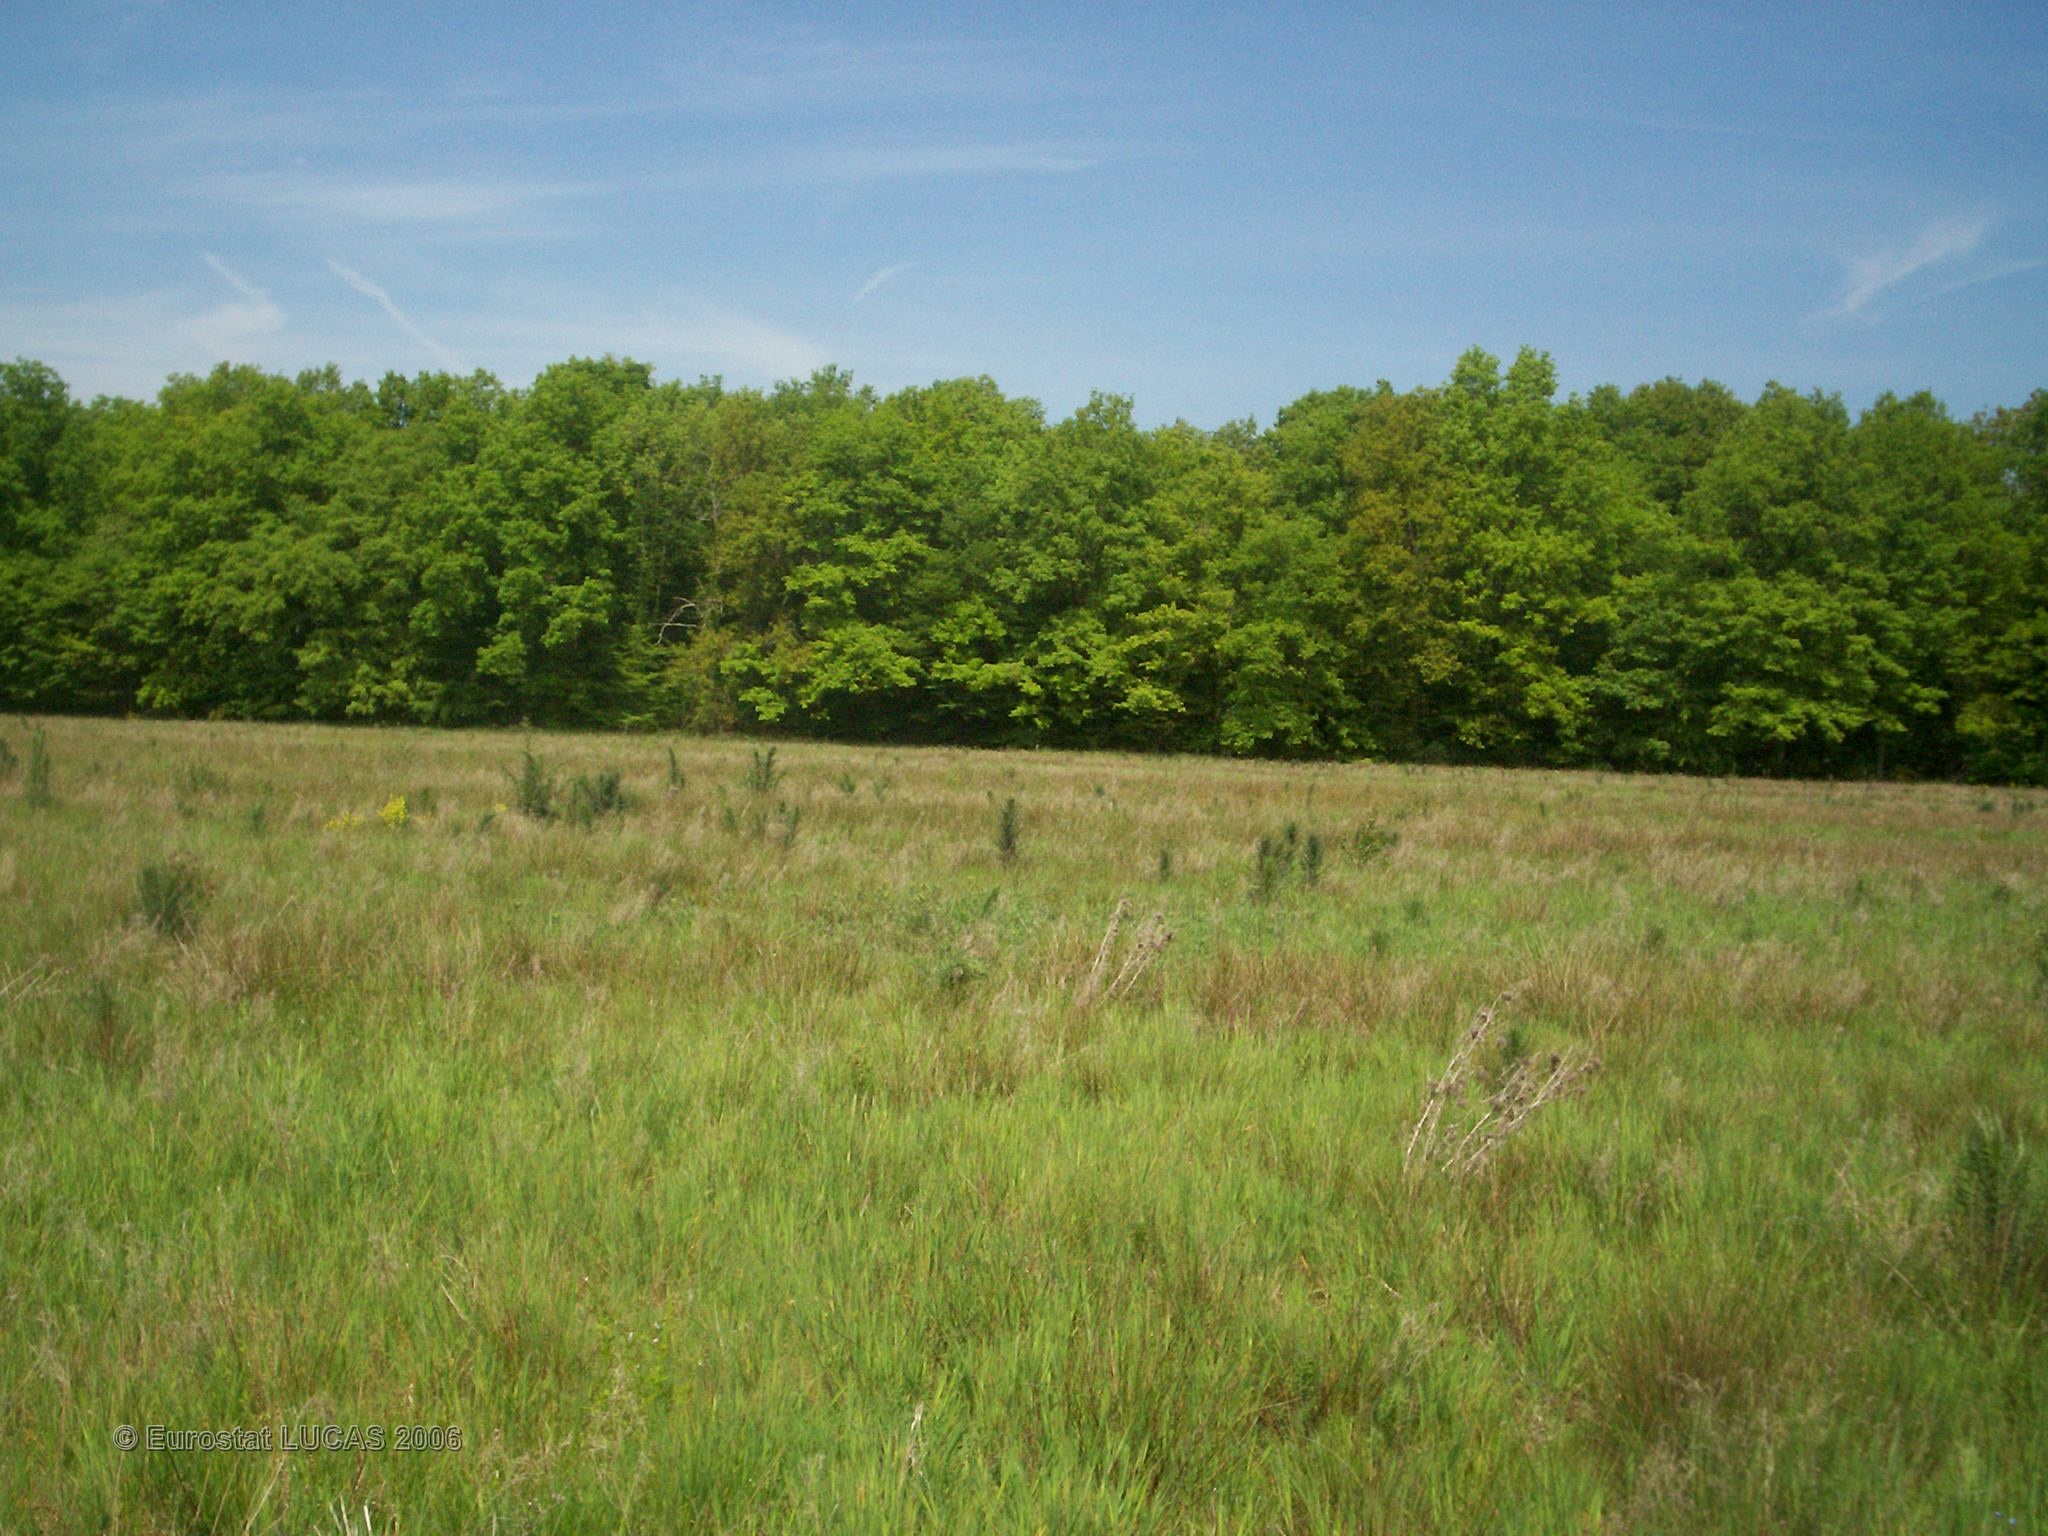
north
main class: Grassland
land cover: Grassland without tree/shrub cover
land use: Agriculture (excluding fallow land and kitchen gardens)
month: May
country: FR
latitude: 47.6384
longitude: 2.9794
